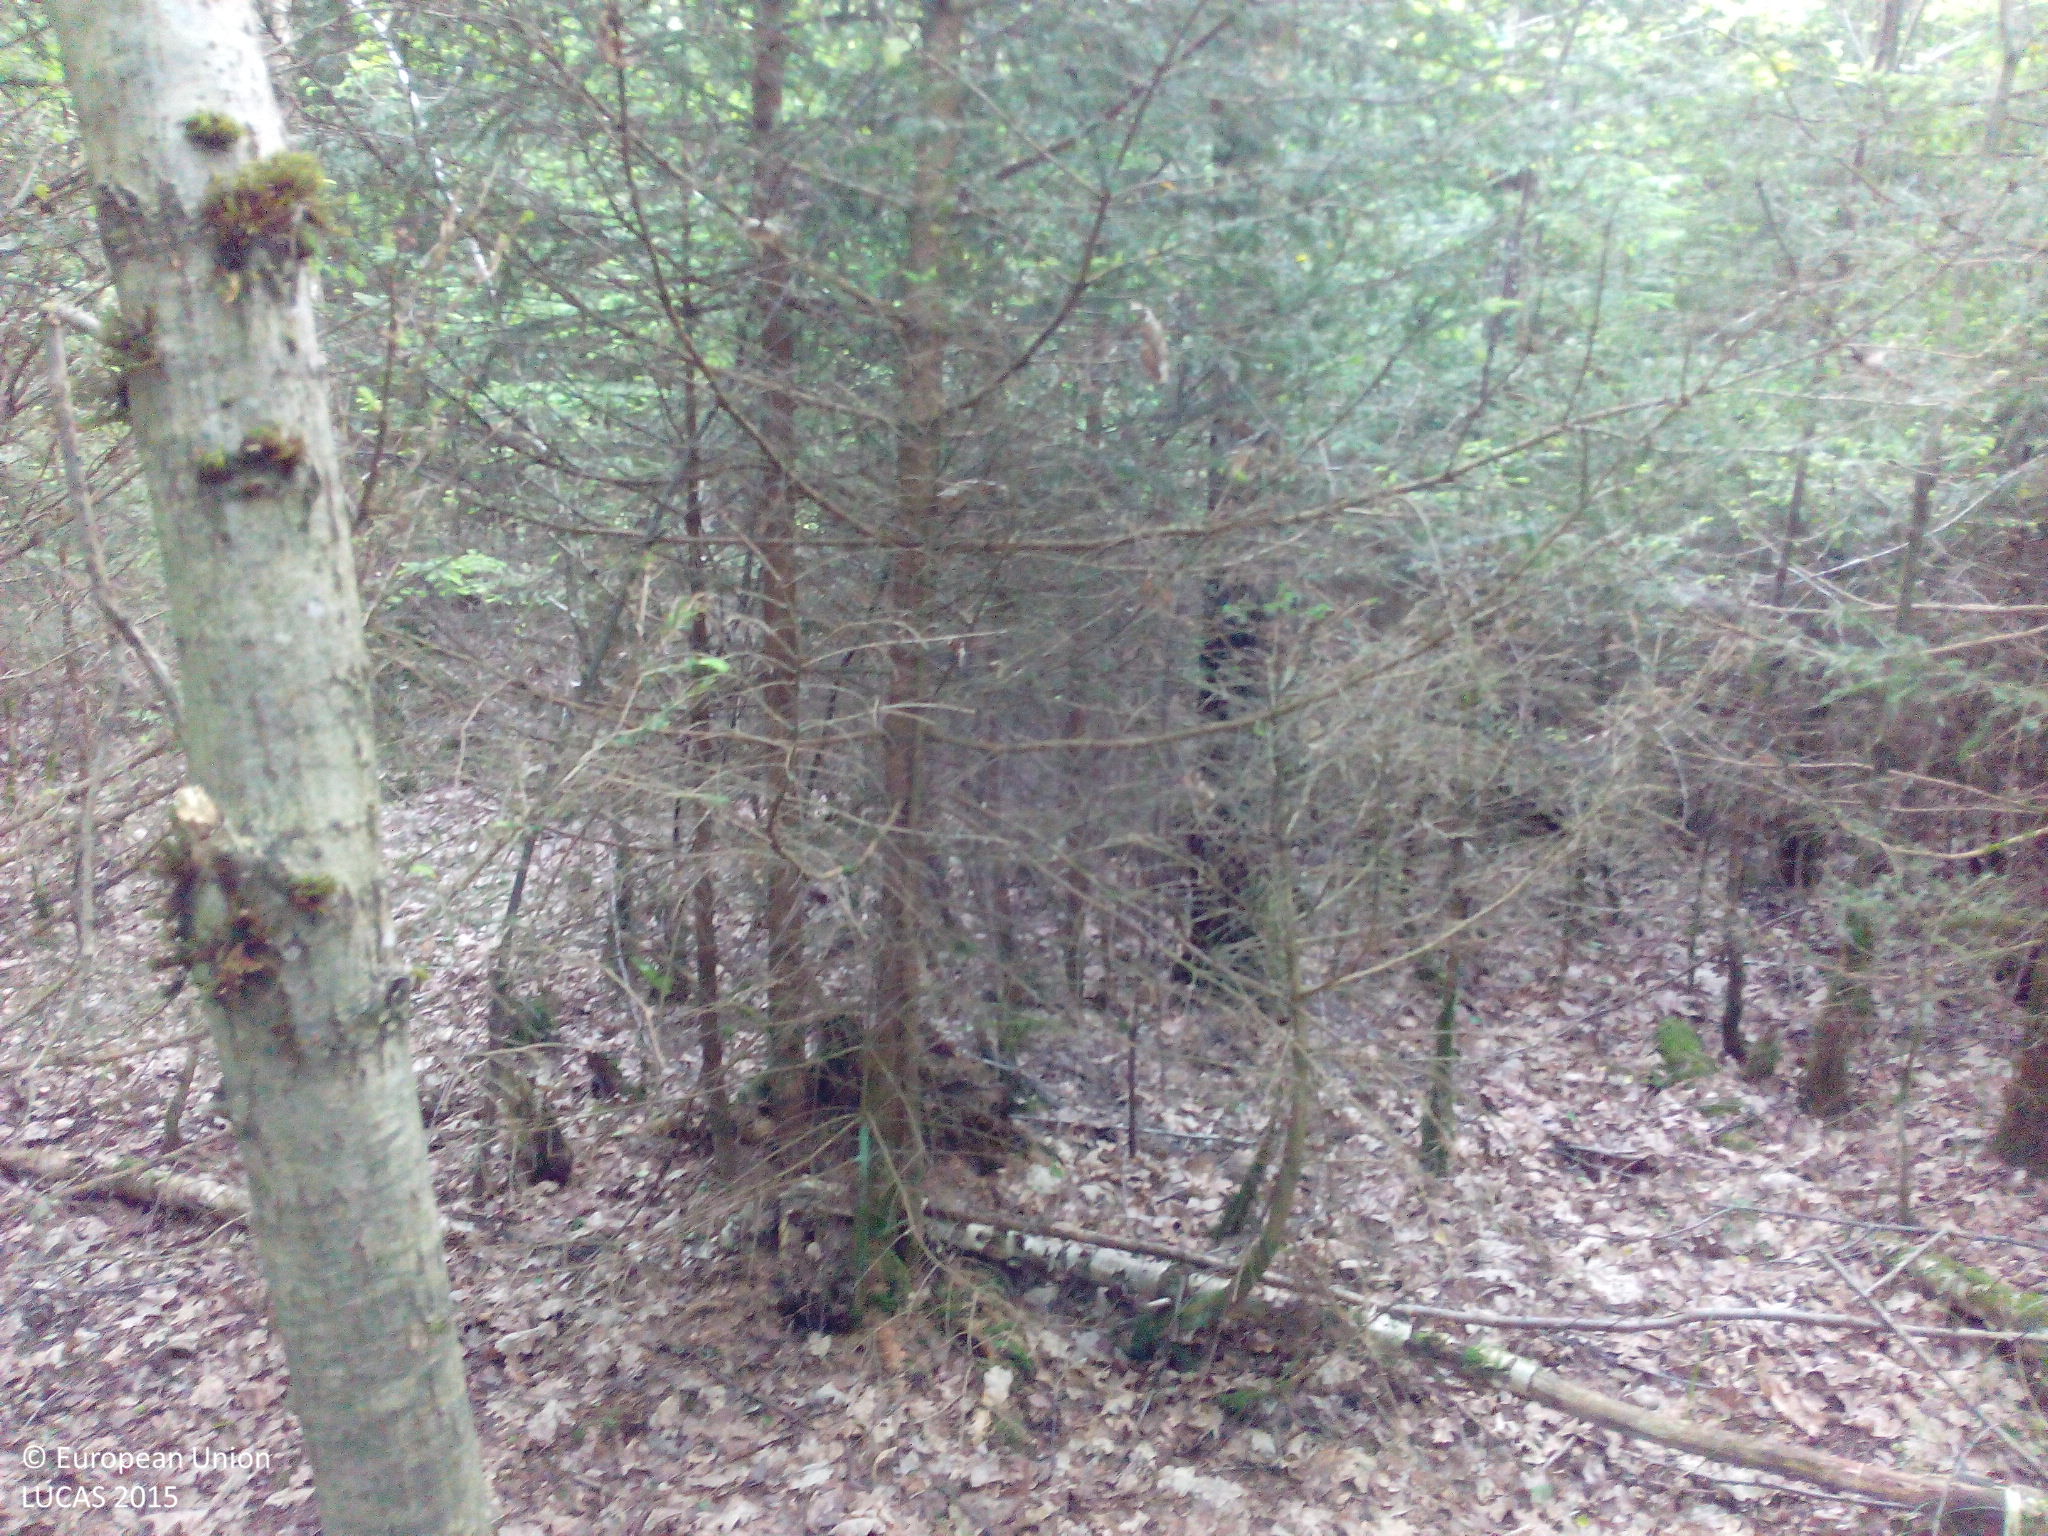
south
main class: Woodland
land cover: Spruce dominated mixed woodland
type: hemiboreal forest and nemoral coniferous forest and mixed broadleaved-coniferous forest
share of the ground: > 75 %
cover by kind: coniferous forest trees 70 %, broadleaved forest trees 30 %
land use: Forestry
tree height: > 5 m
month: May
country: DE
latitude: 48.2232
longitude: 10.2556
